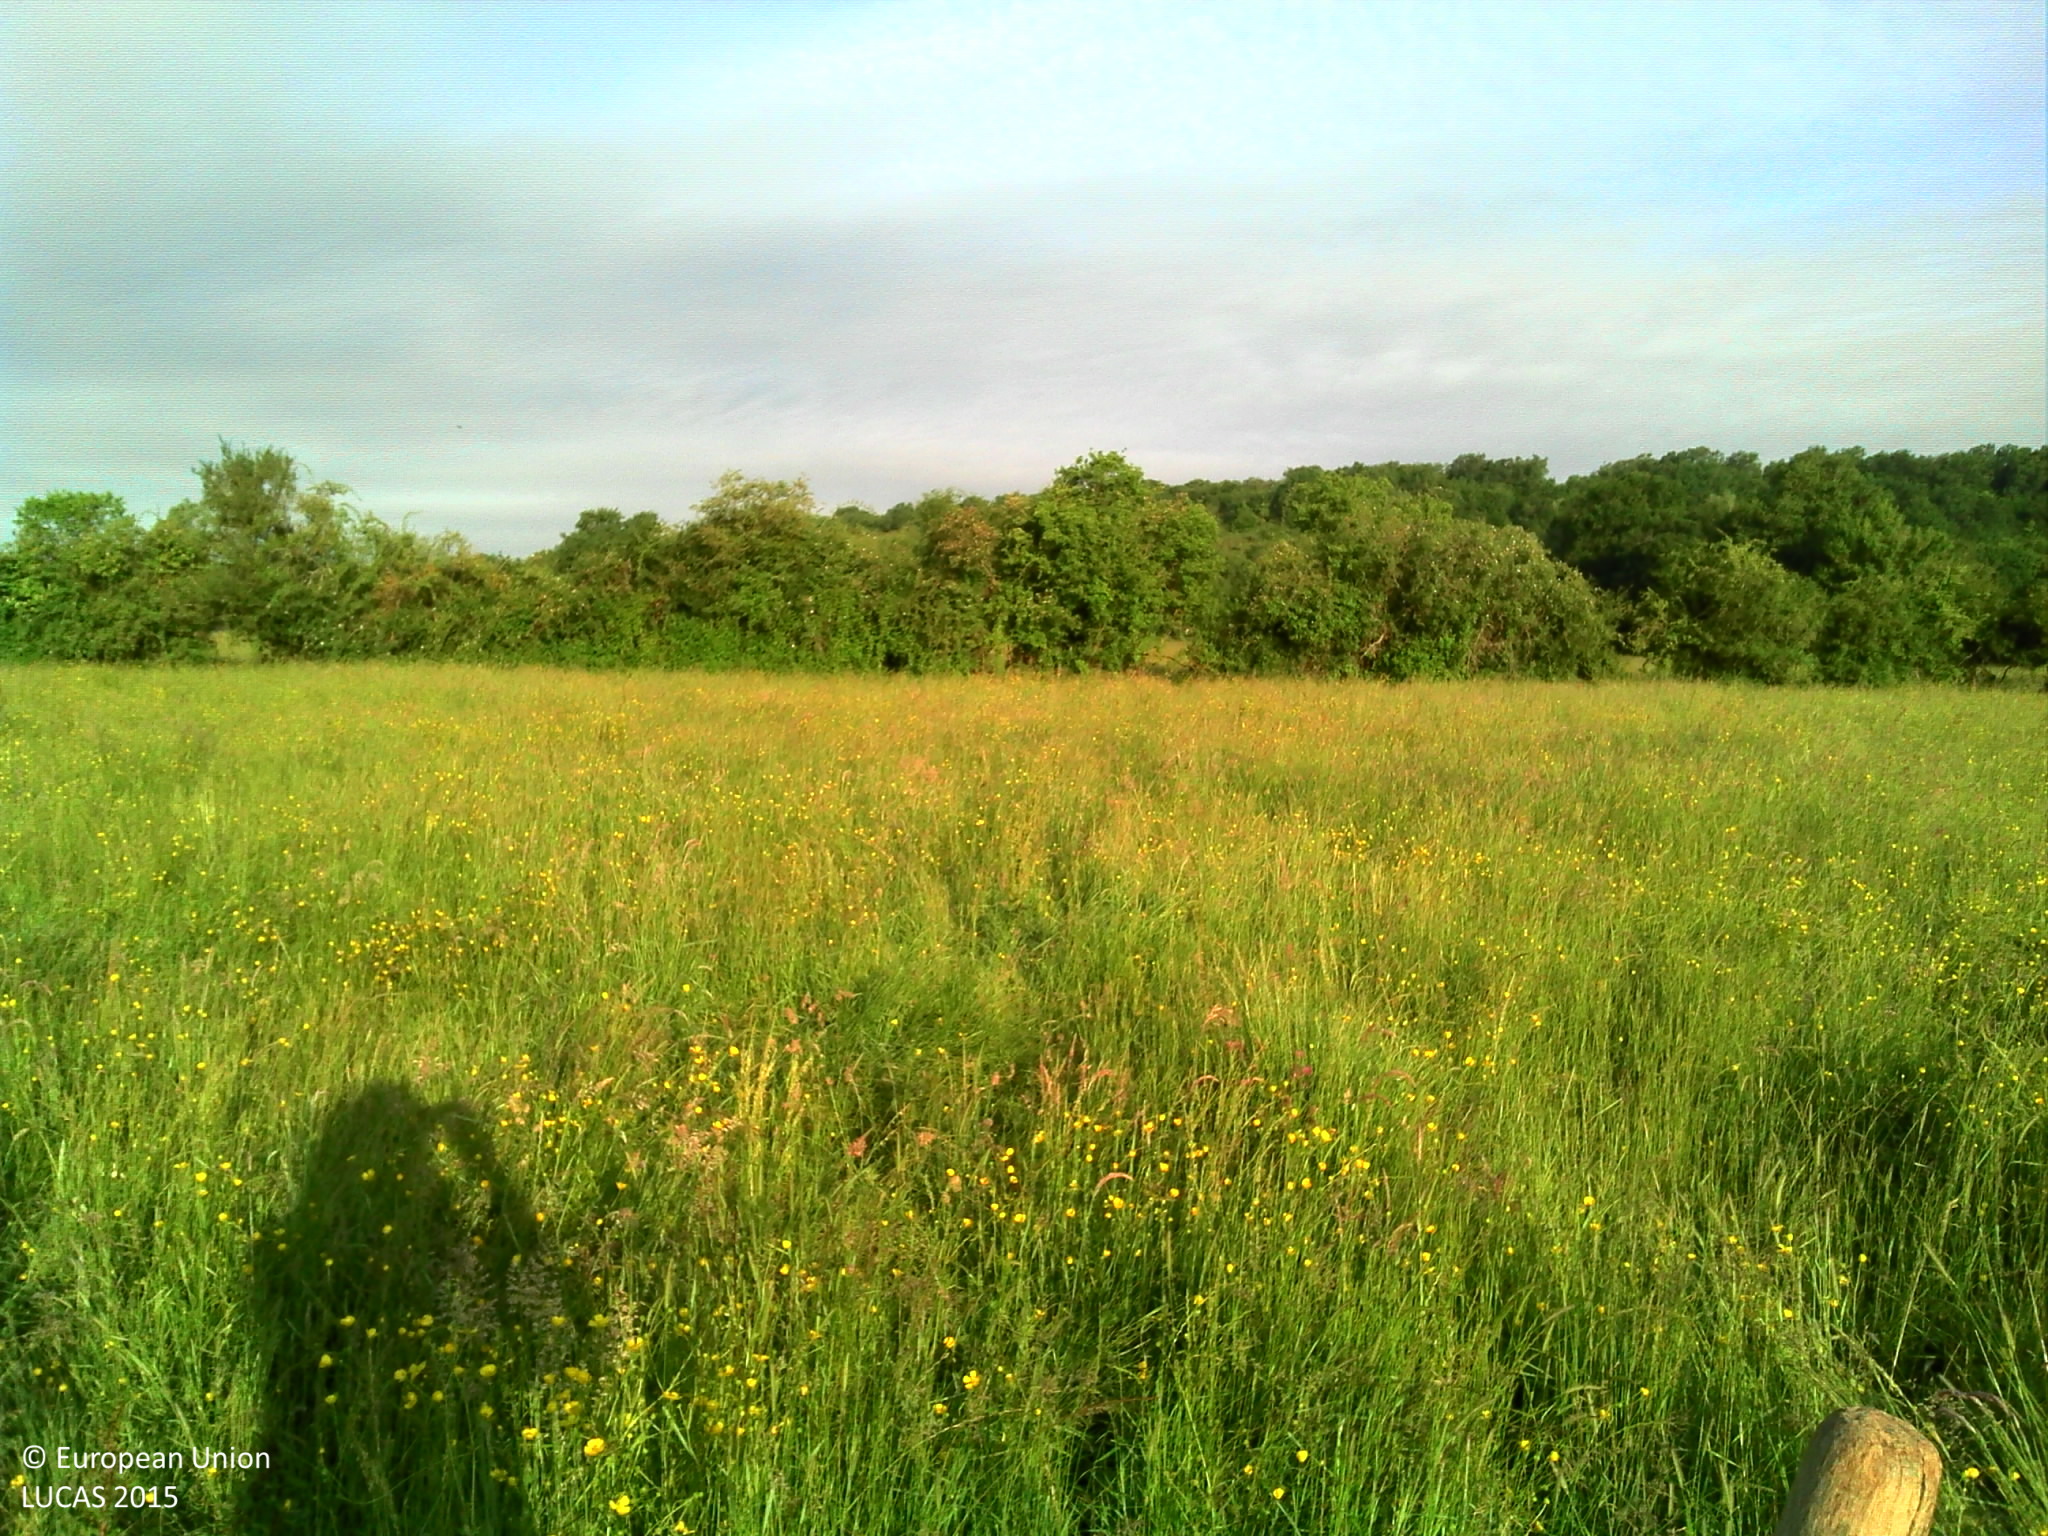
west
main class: Grassland
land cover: Grassland without tree/shrub cover
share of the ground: > 75 %
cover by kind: herbaceous plants 100 %
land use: Agriculture (excluding fallow land and kitchen gardens)
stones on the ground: < 10 %
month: June
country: FR
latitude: 46.9747
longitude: 2.7782
